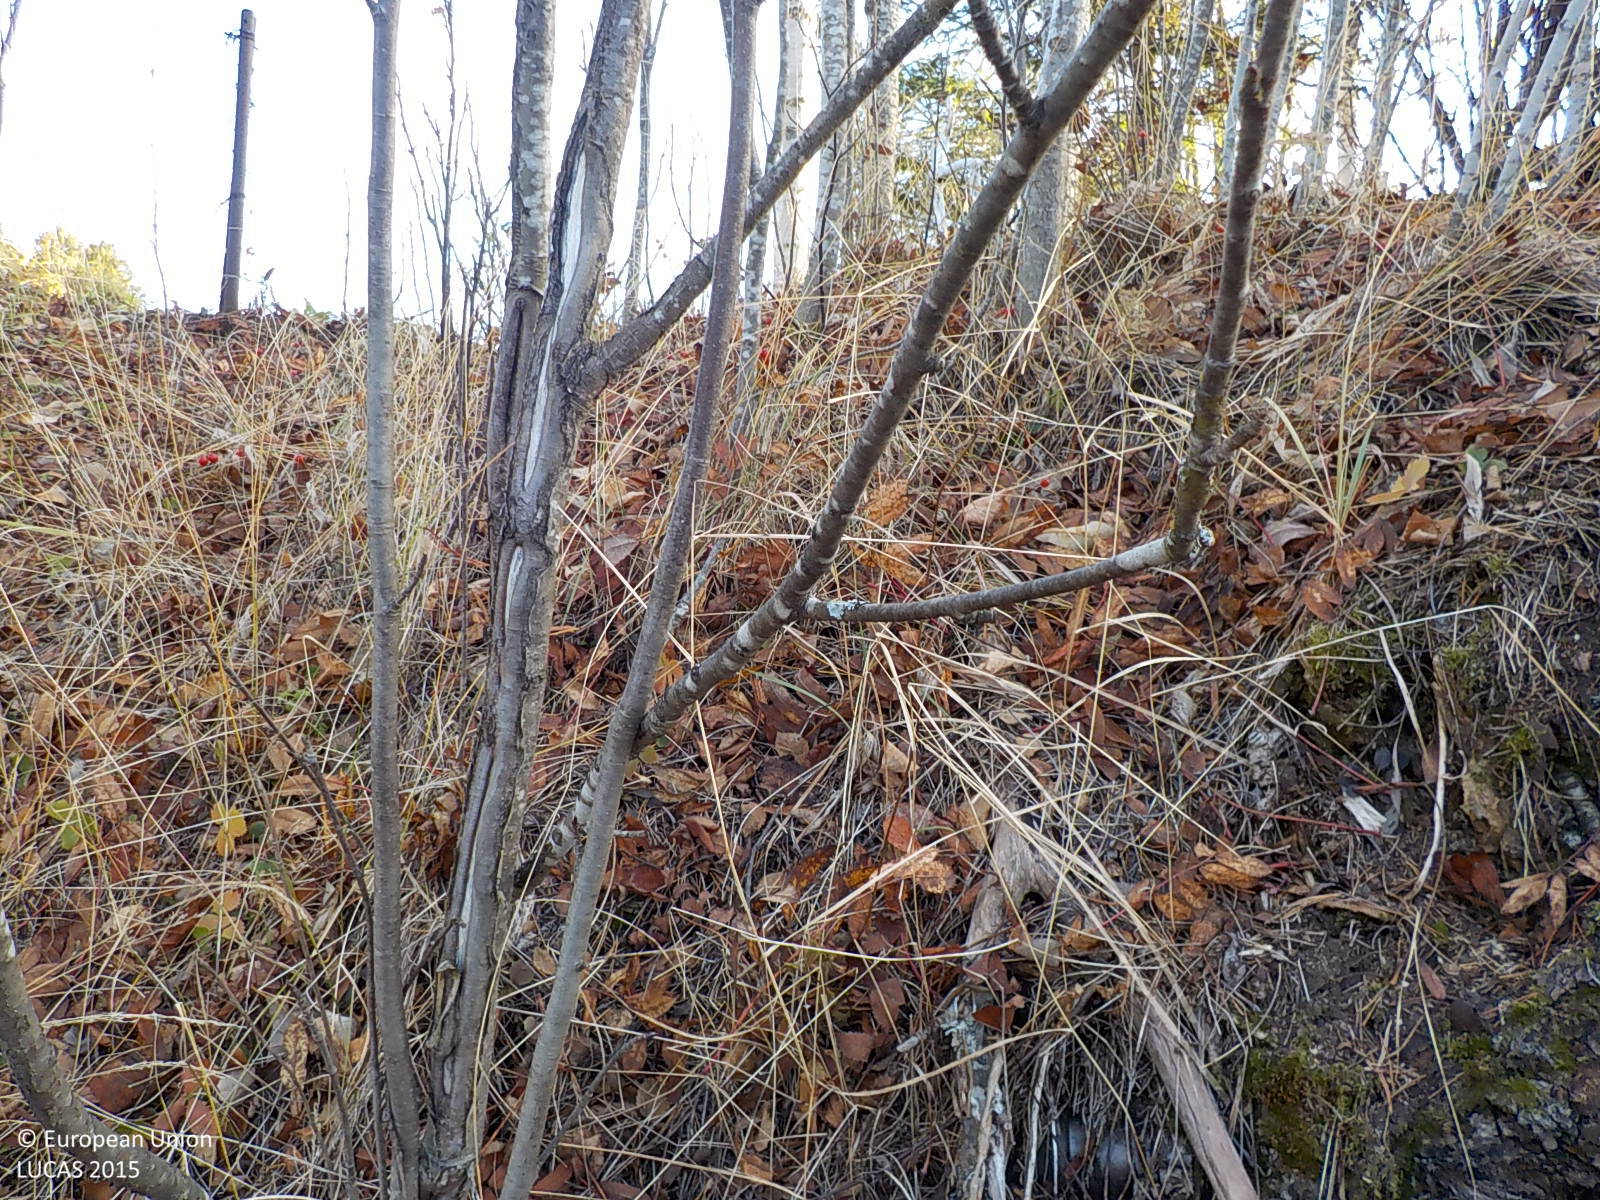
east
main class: Woodland
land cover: Broadleaved woodland
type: boreal forest
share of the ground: > 75 %
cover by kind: broadleaved forest trees 90 %, herbaceous plants 10 %
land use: Semi-natural and natural areas not in use
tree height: > 5 m
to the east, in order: Broadleaved woodland; Grassland without tree/shrub cover; Tracks; Grassland without tree/shrub cover; Artificial constructions in urban areas; Grassland without tree/shrub cover
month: October
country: SE
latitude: 63.3342
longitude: 17.0648
